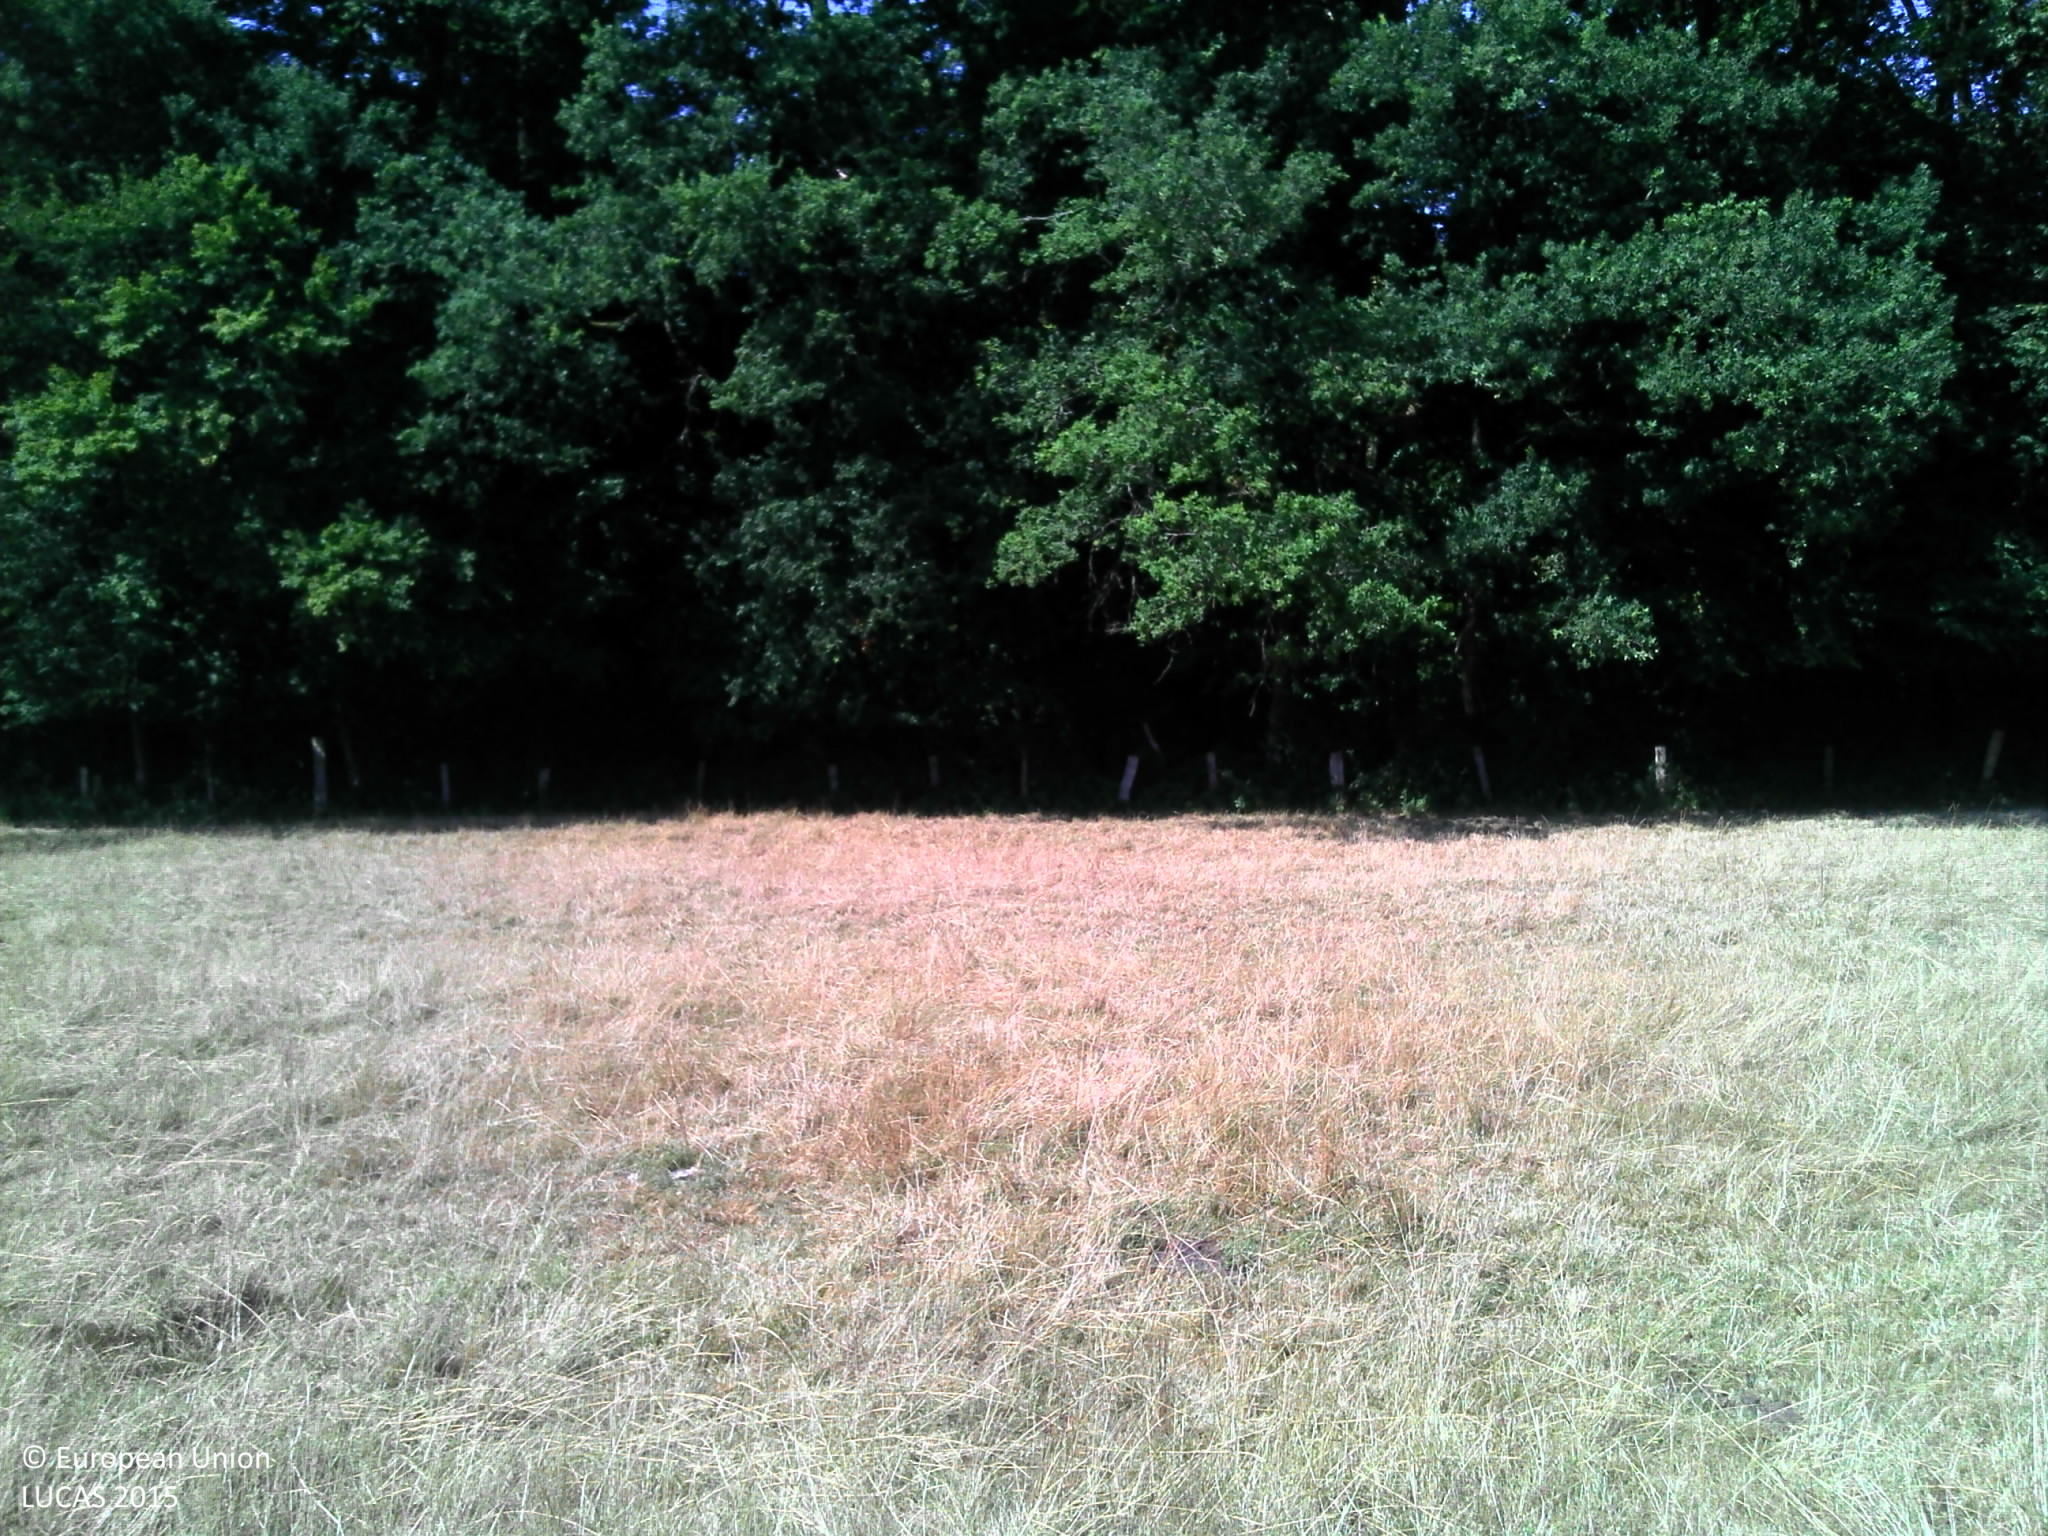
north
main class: Grassland
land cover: Grassland without tree/shrub cover
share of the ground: > 75 %
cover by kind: herbaceous plants 100 %
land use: Agriculture (excluding fallow land and kitchen gardens)
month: July
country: FR
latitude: 49.0525
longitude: 5.1132
